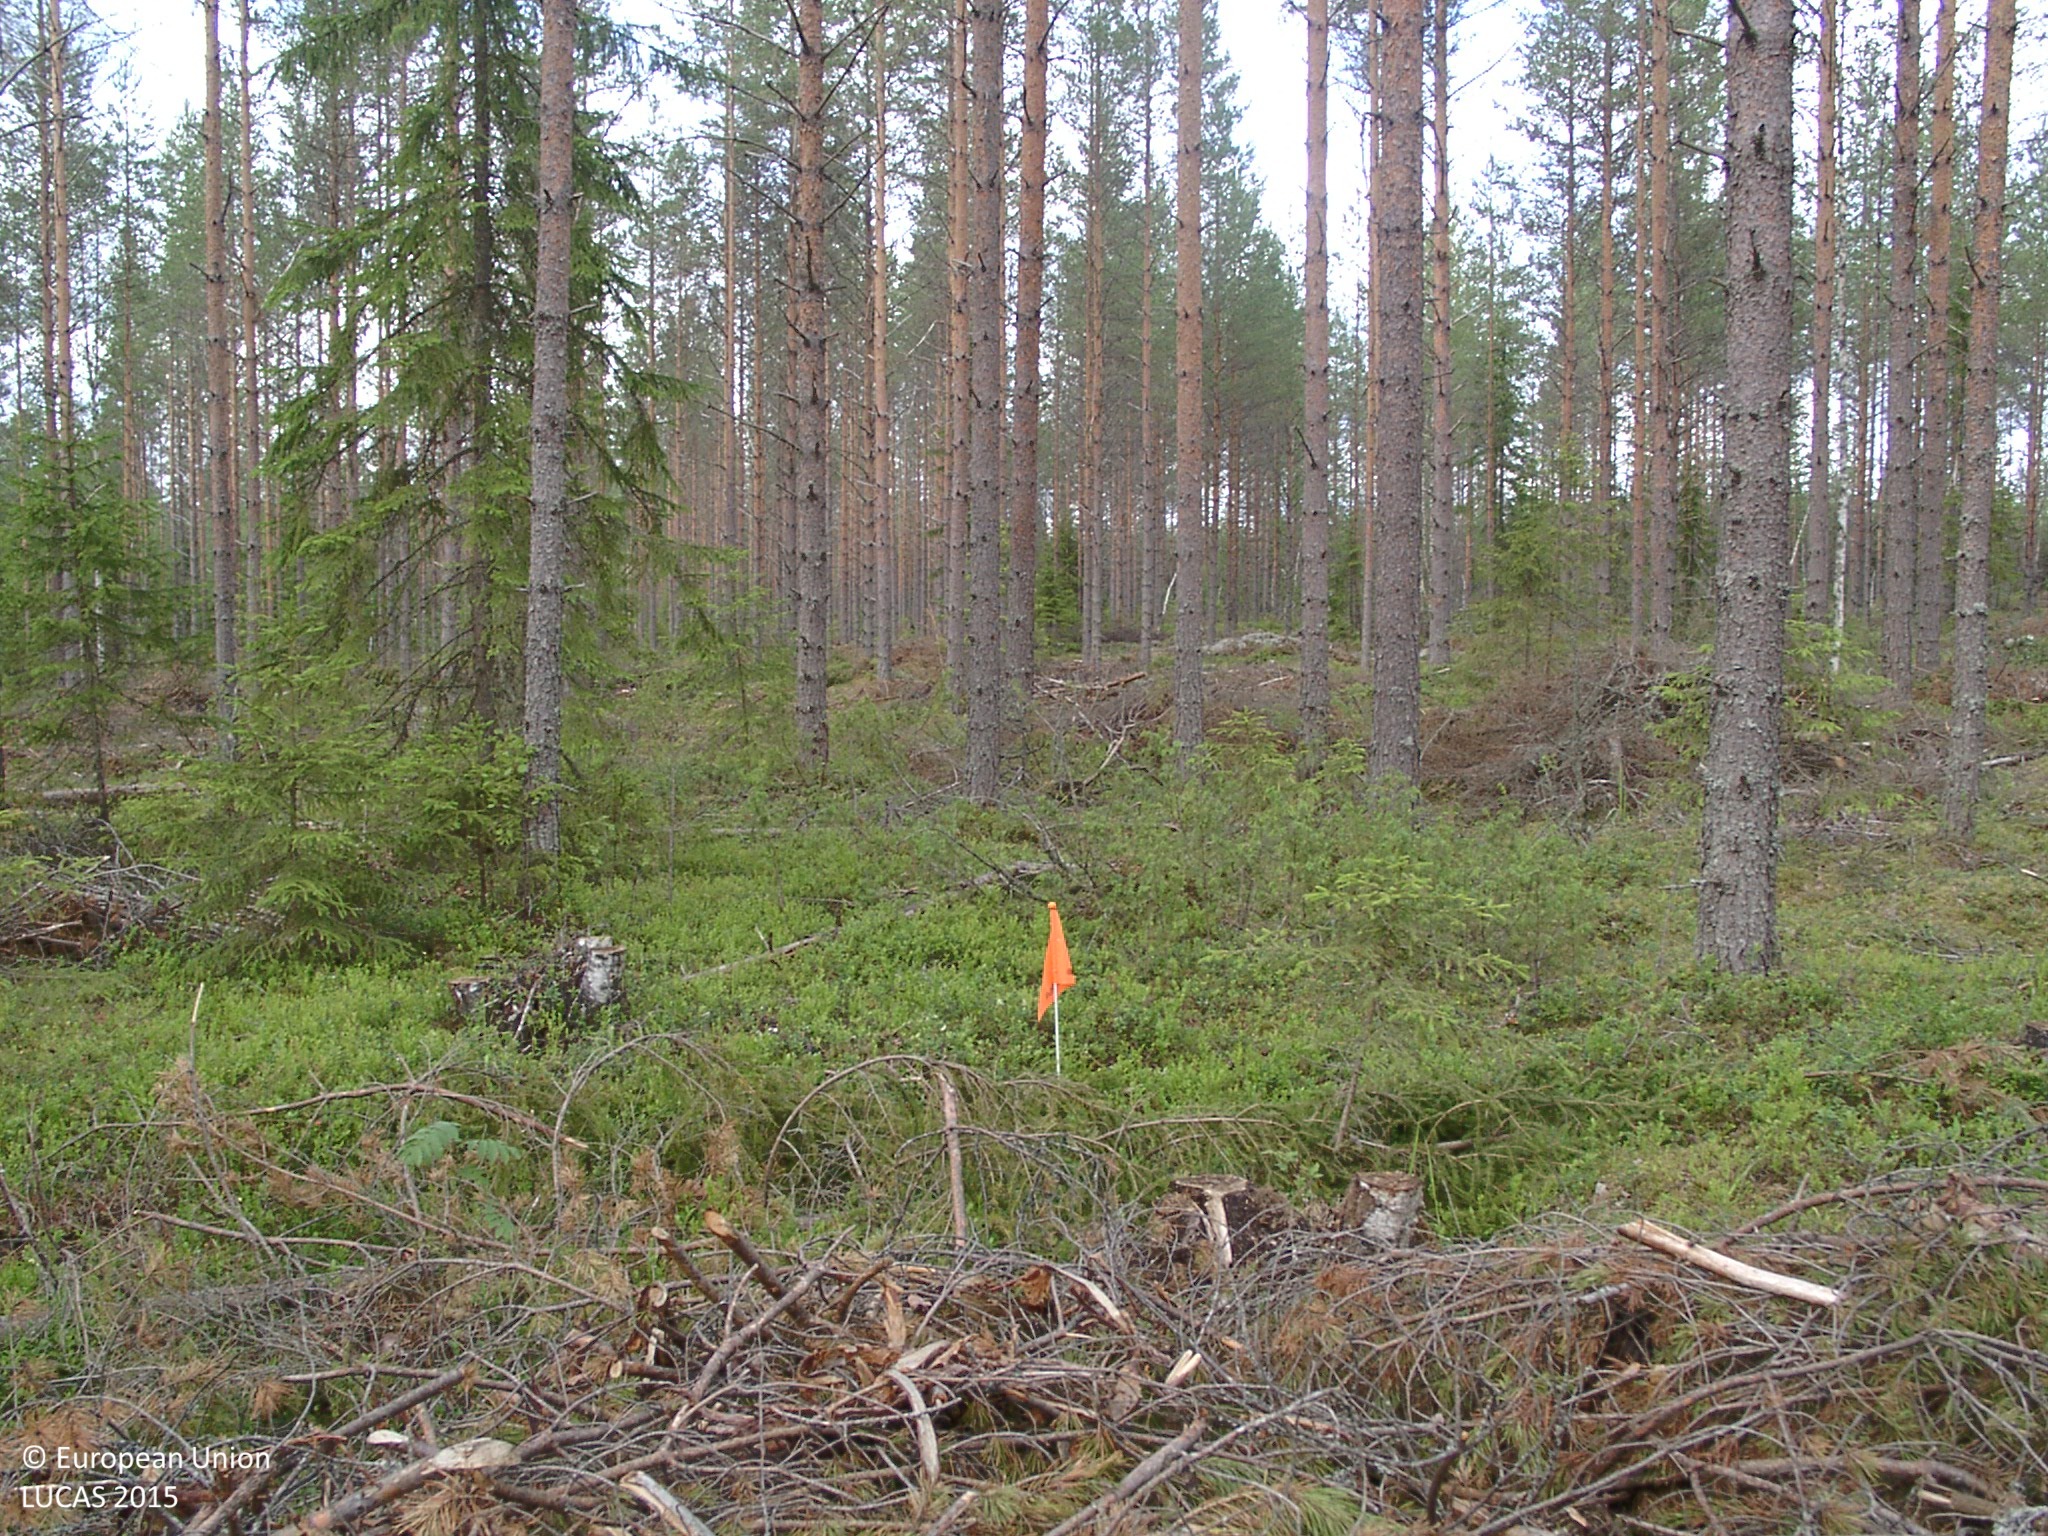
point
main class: Woodland
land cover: Pine dominated coniferous woodland
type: boreal forest
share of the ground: 50 - 75 %
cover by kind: coniferous forest trees 55 %, shrubs 15 %, lichens and mosses 15 %
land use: Forestry
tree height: > 5 m
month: July
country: FI
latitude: 62.3136
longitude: 25.0153
